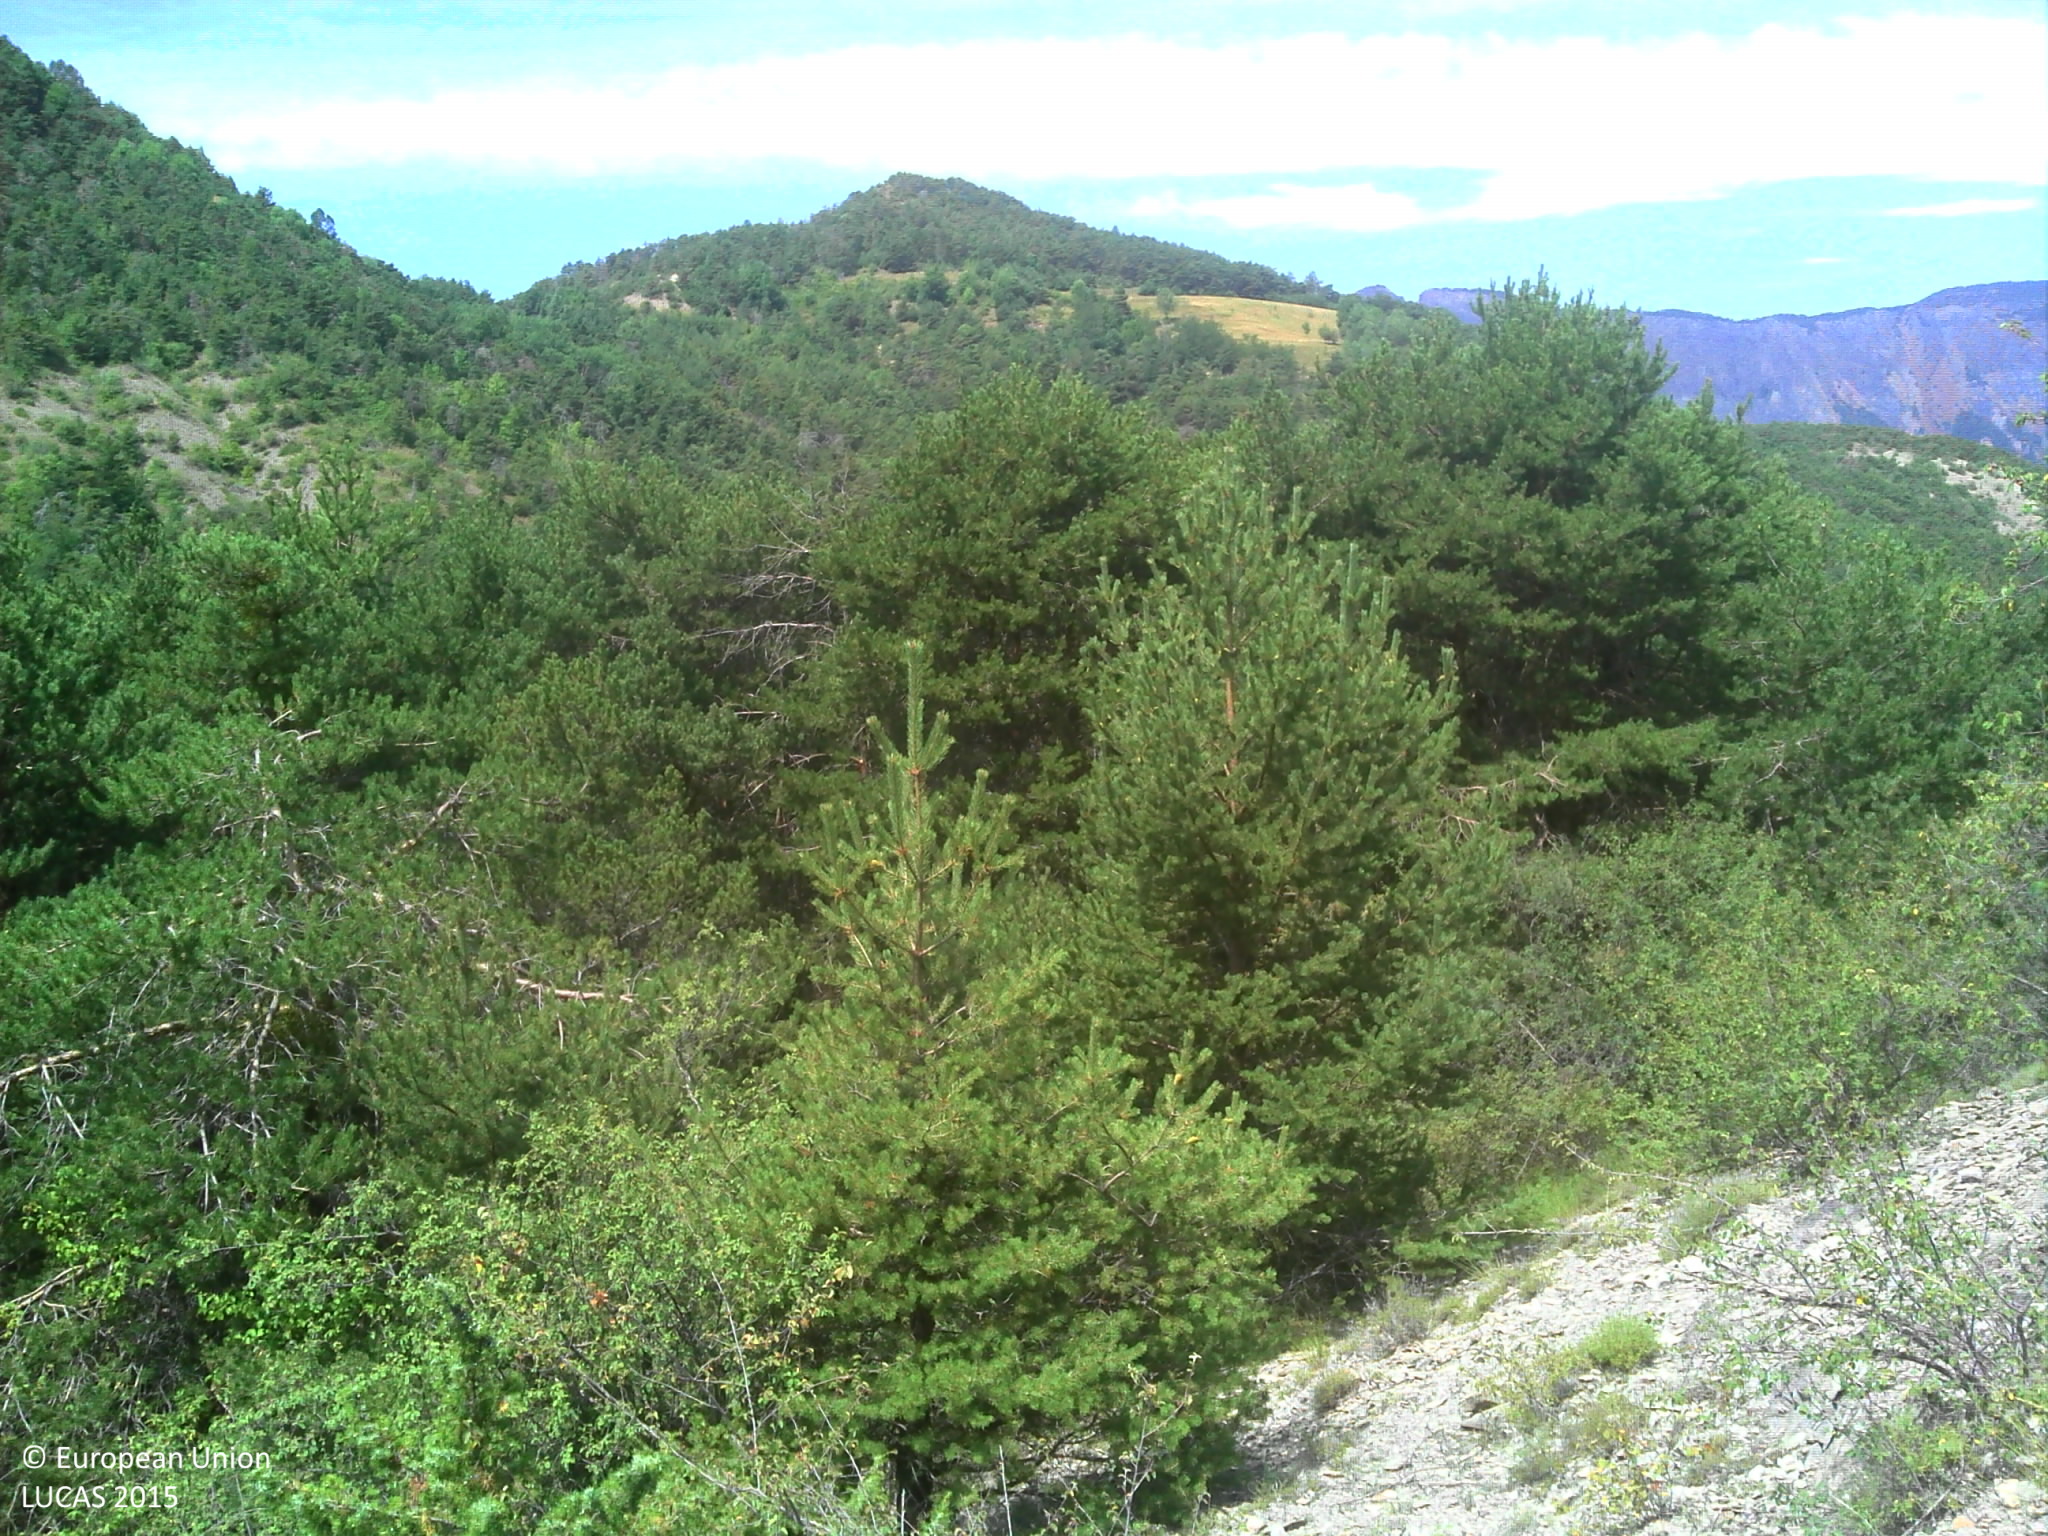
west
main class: Shrubland
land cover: Shrubland with sparse tree cover
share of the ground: 50 - 75 %
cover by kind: shrubs 50 %, unconsolidated bare surface 25 %, herbaceous plants 20 %, coniferous forest trees 5 %
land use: Semi-natural and natural areas not in use
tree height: < 5 m
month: July
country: FR
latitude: 44.4651
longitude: 6.2987
